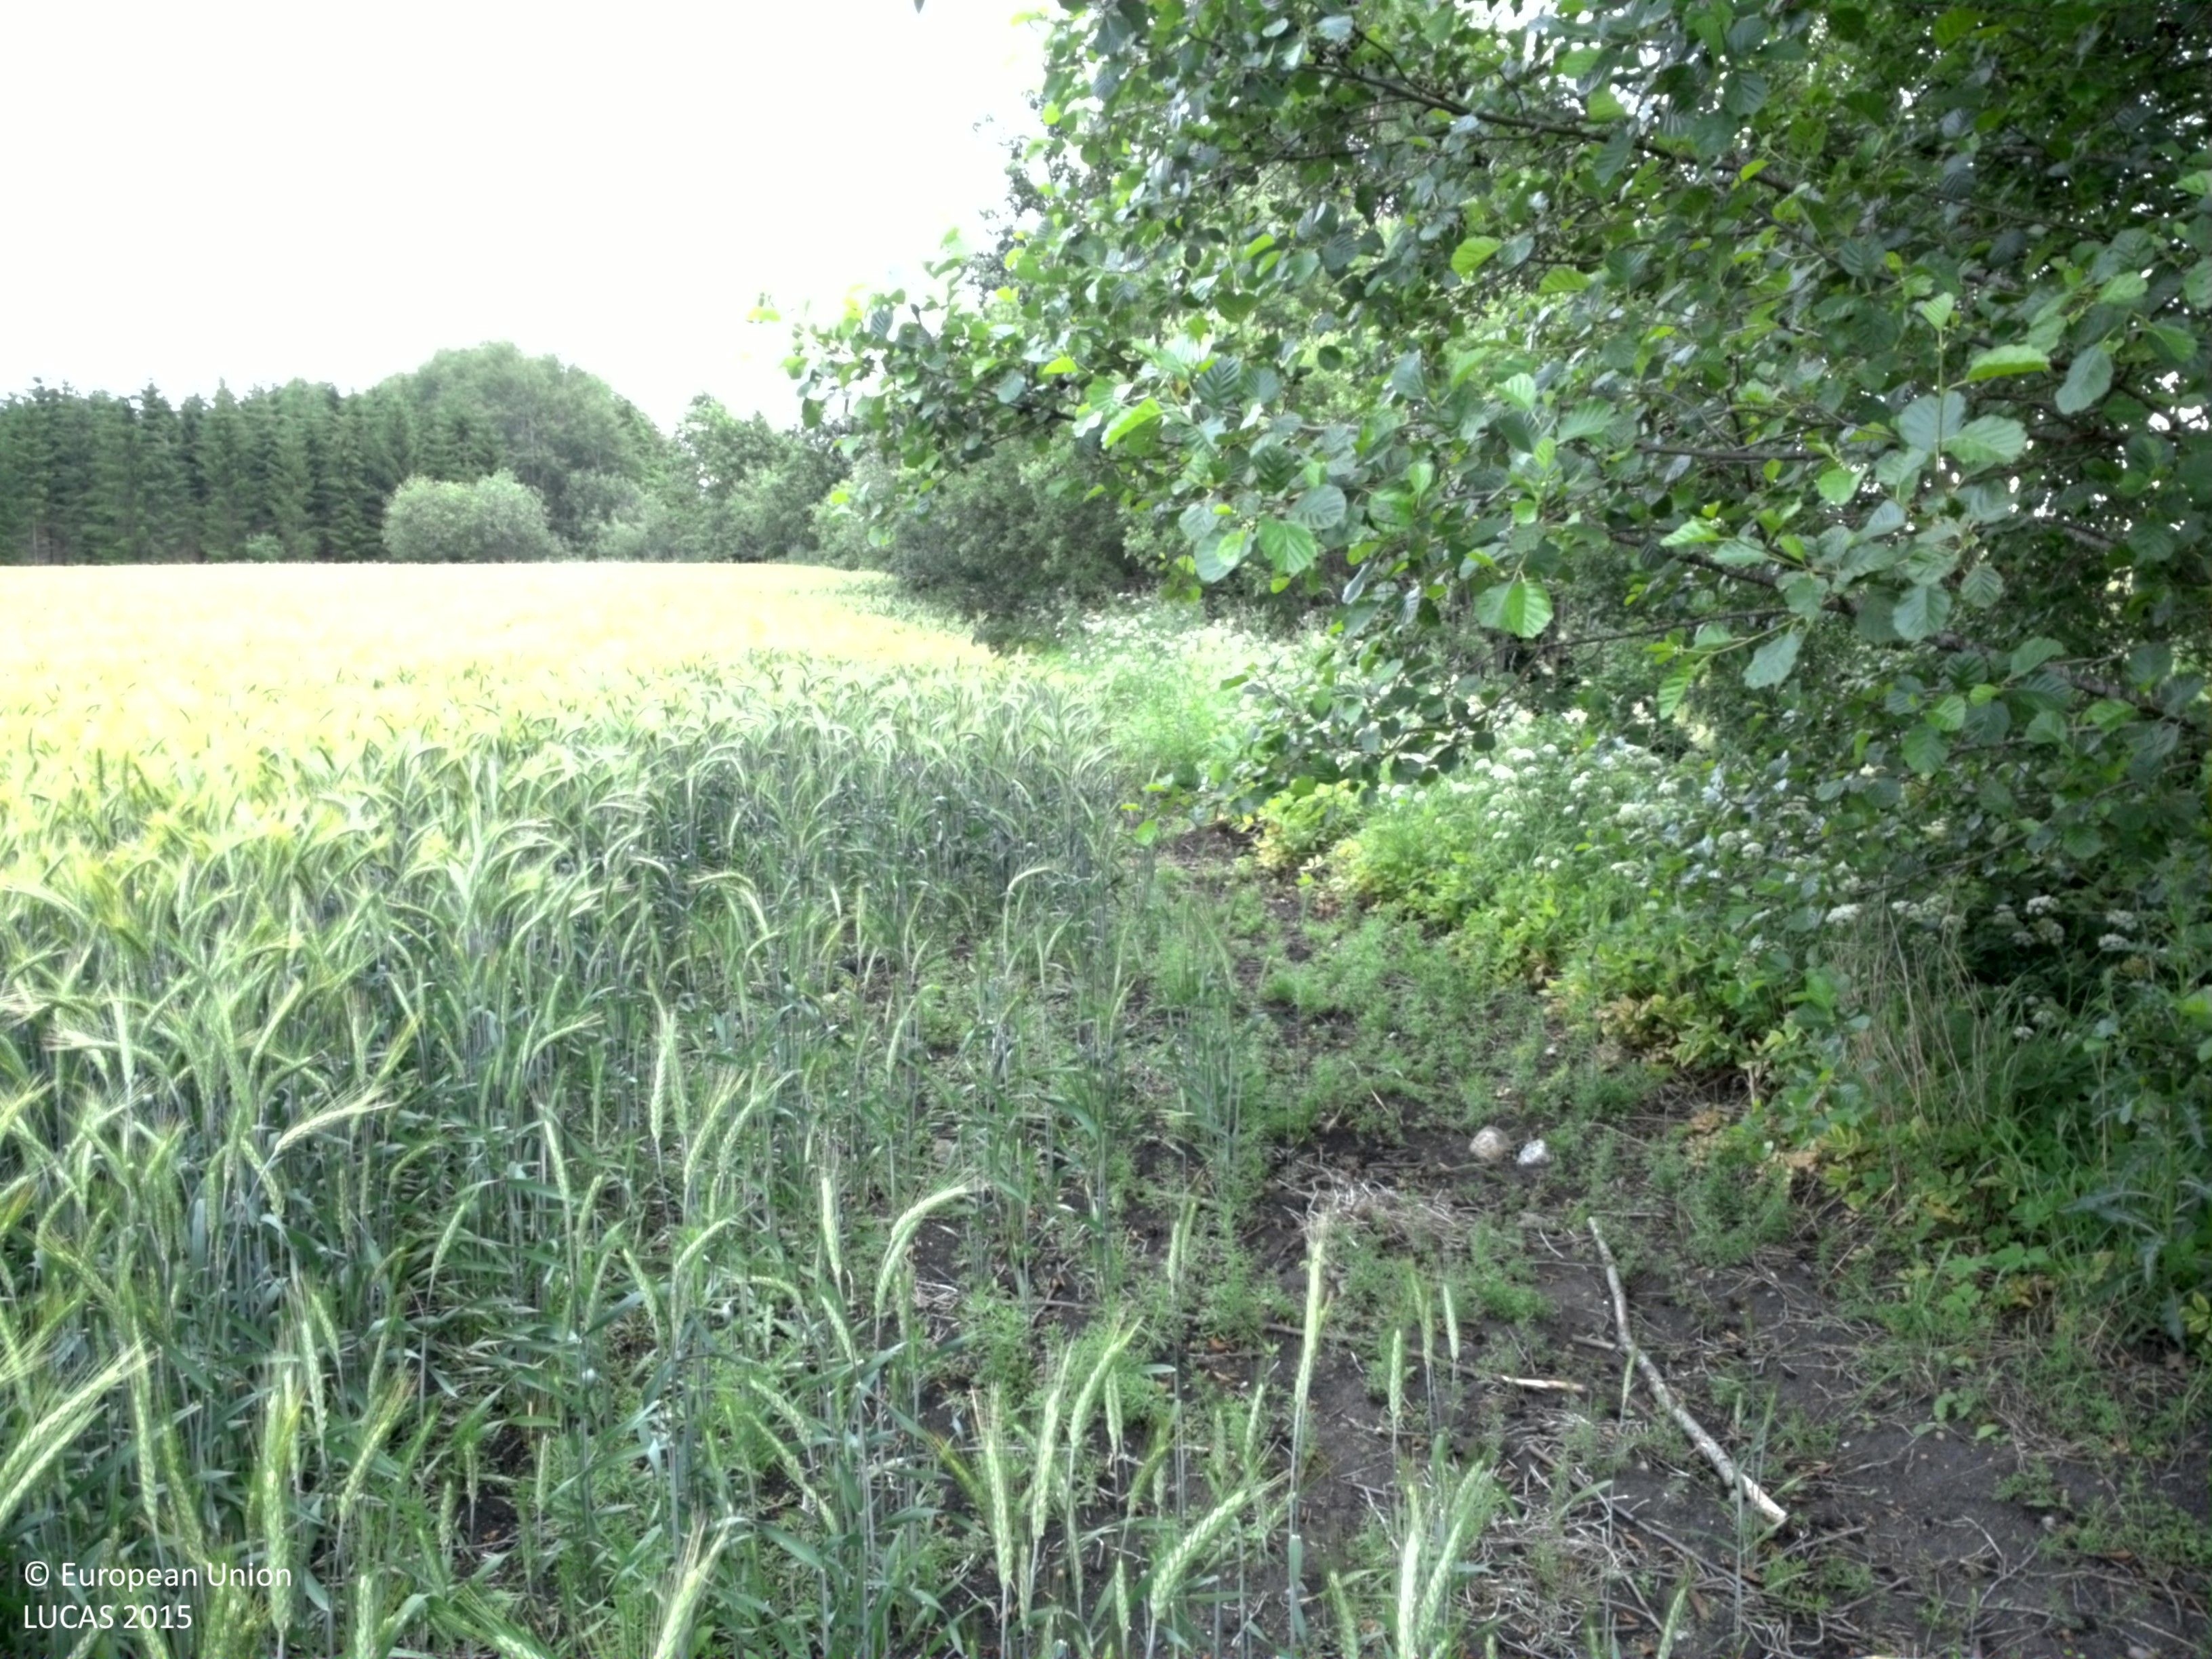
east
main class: Cropland
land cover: Rye
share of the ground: > 75 %
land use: Agriculture (excluding fallow land and kitchen gardens)
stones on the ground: < 10 %
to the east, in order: Rye; Ditches and canals; Spruce dominated coniferous woodland; Broadleaved woodland; Ditches and canals; Broadleaved woodland; Barley; Ditches and canals; Barley
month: July
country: SE
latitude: 59.7771
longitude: 18.5302
